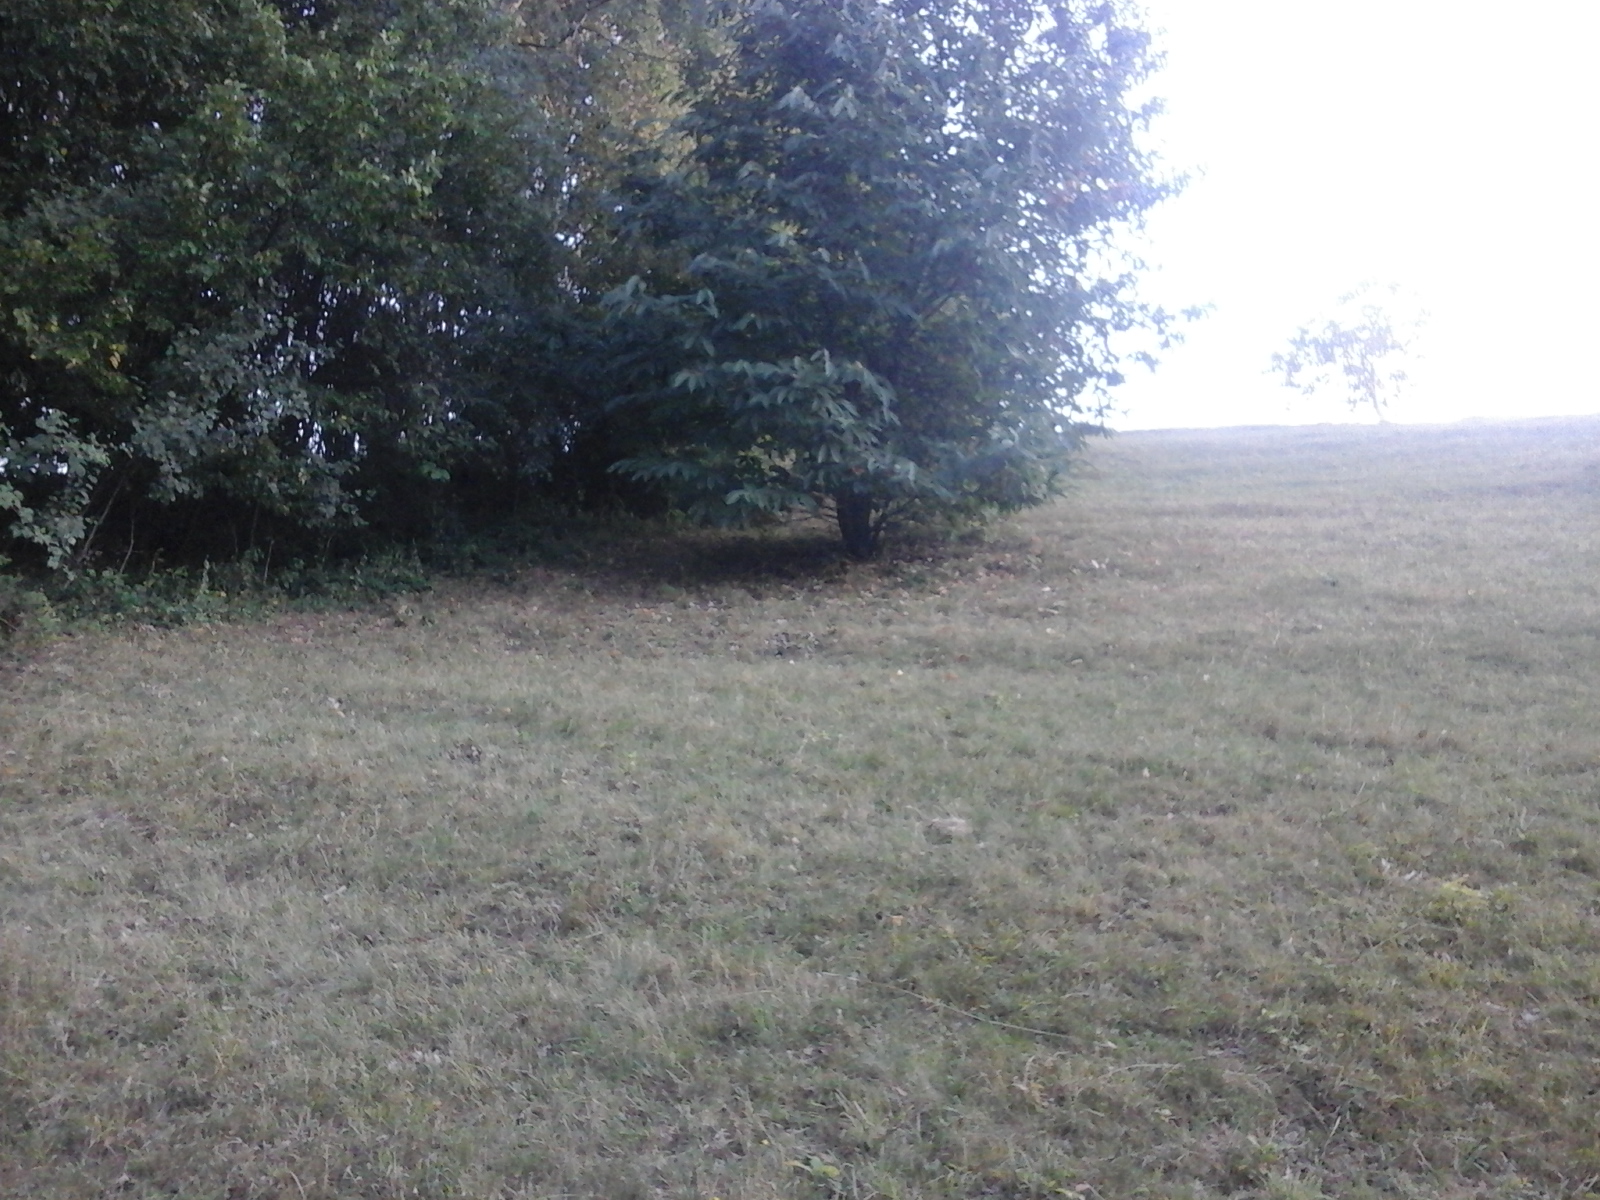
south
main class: Cropland
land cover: Other fruit trees and berries
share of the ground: > 75 %
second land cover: Grassland without tree/shrub cover
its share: > 75 %
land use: Agriculture (excluding fallow land and kitchen gardens)
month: September
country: RO
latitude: 47.4678
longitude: 23.5945
